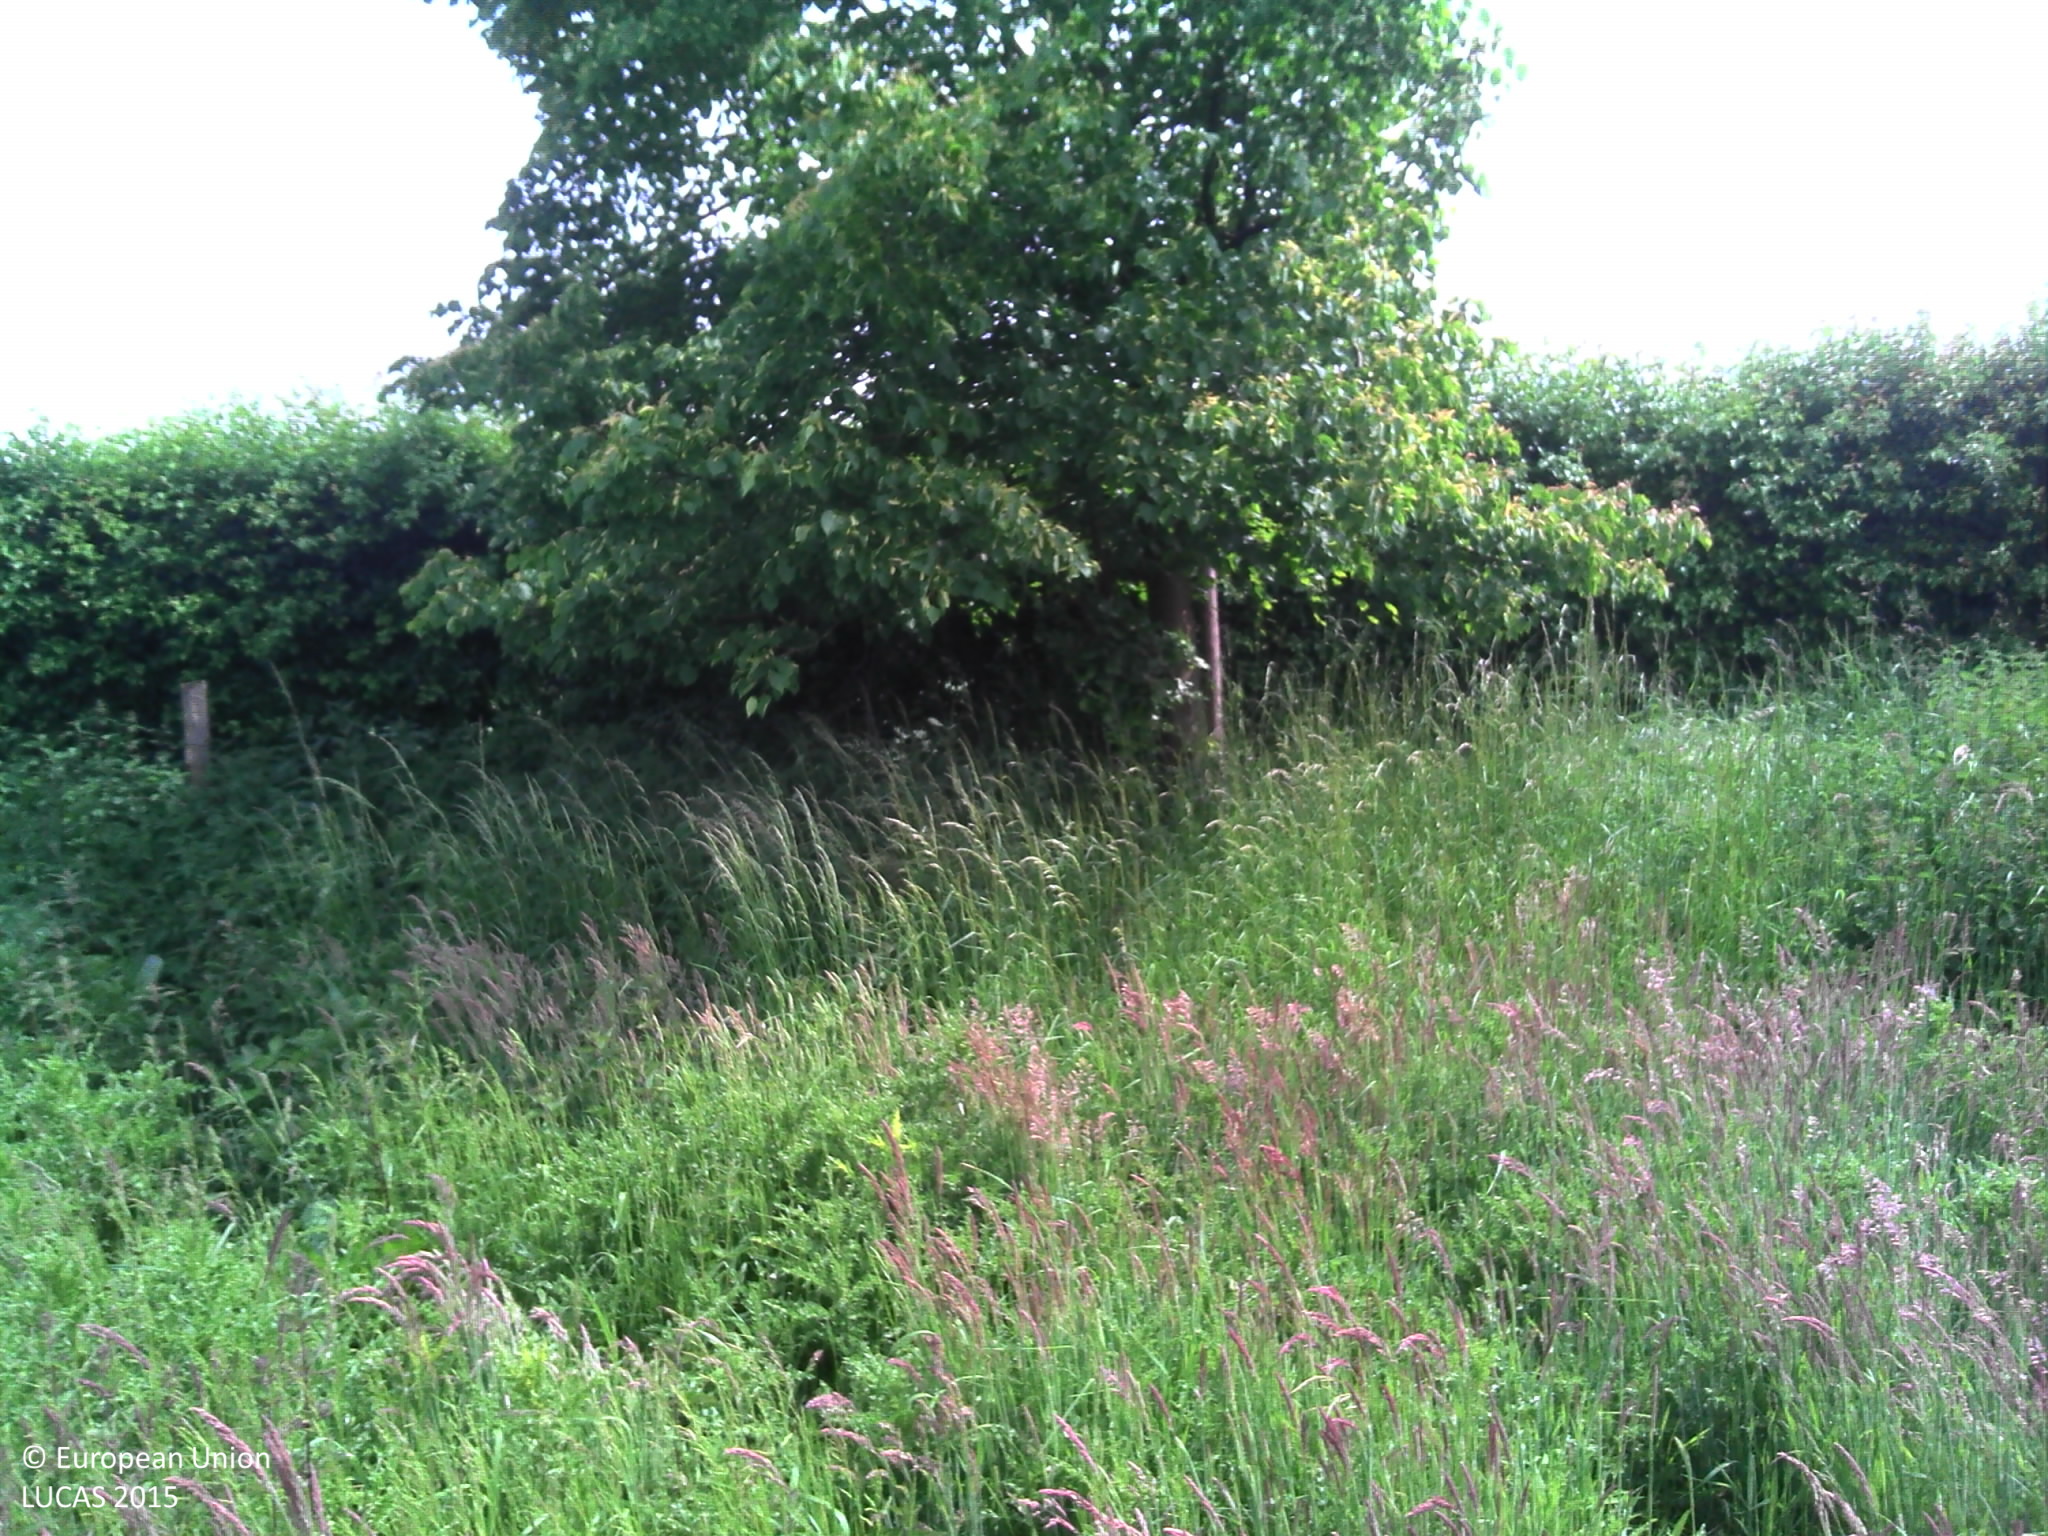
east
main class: Grassland
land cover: Grassland without tree/shrub cover
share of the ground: > 75 %
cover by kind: herbaceous plants 100 %
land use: Agriculture (excluding fallow land and kitchen gardens)
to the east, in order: Grassland without tree/shrub cover; Fences; Abandoned hedges; Tracks; Grass margins; Common wheat; Grass margins; Tracks; Managed hedges; Ditches and canals; Temporary grasslands
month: May
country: BE
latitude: 50.7589
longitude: 4.5949
